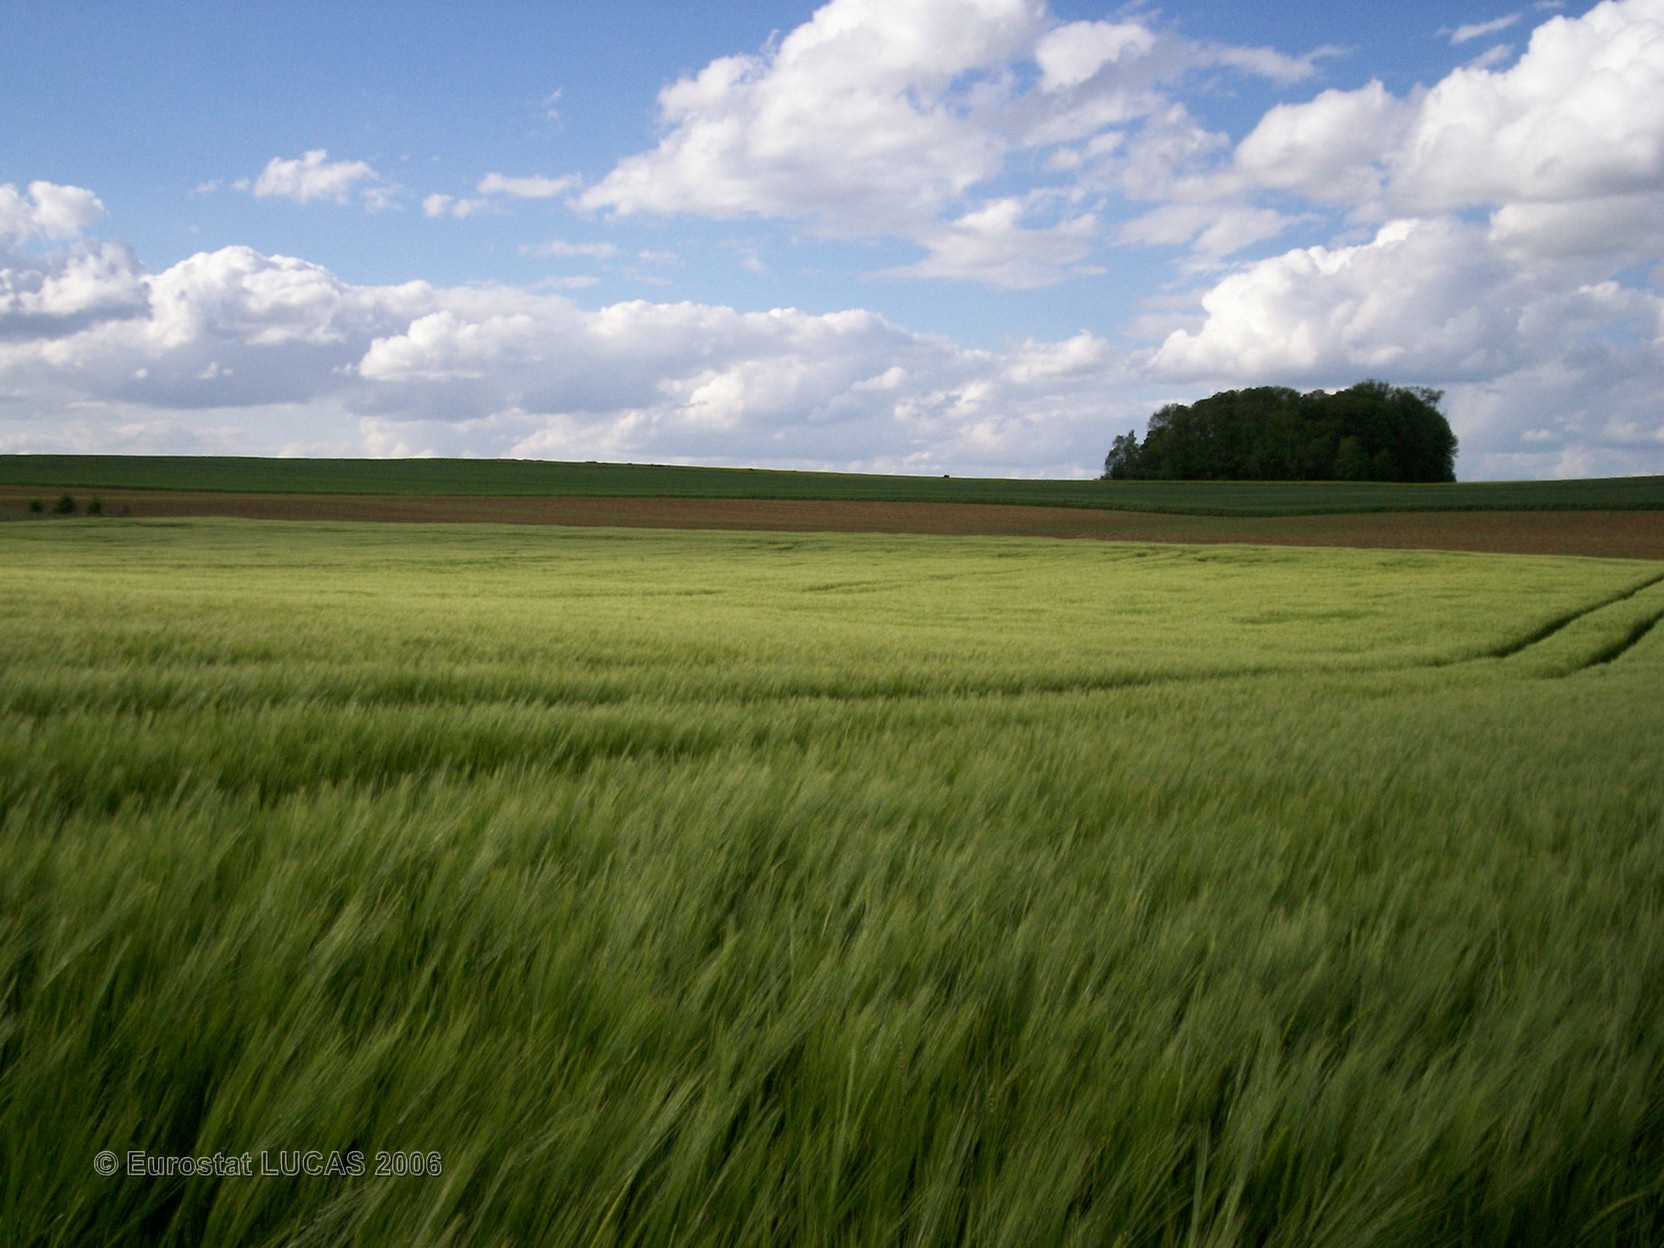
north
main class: Cropland
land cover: Barley
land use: Agriculture (excluding fallow land and kitchen gardens)
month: May
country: FR
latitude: 48.5011
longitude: 6.7931
